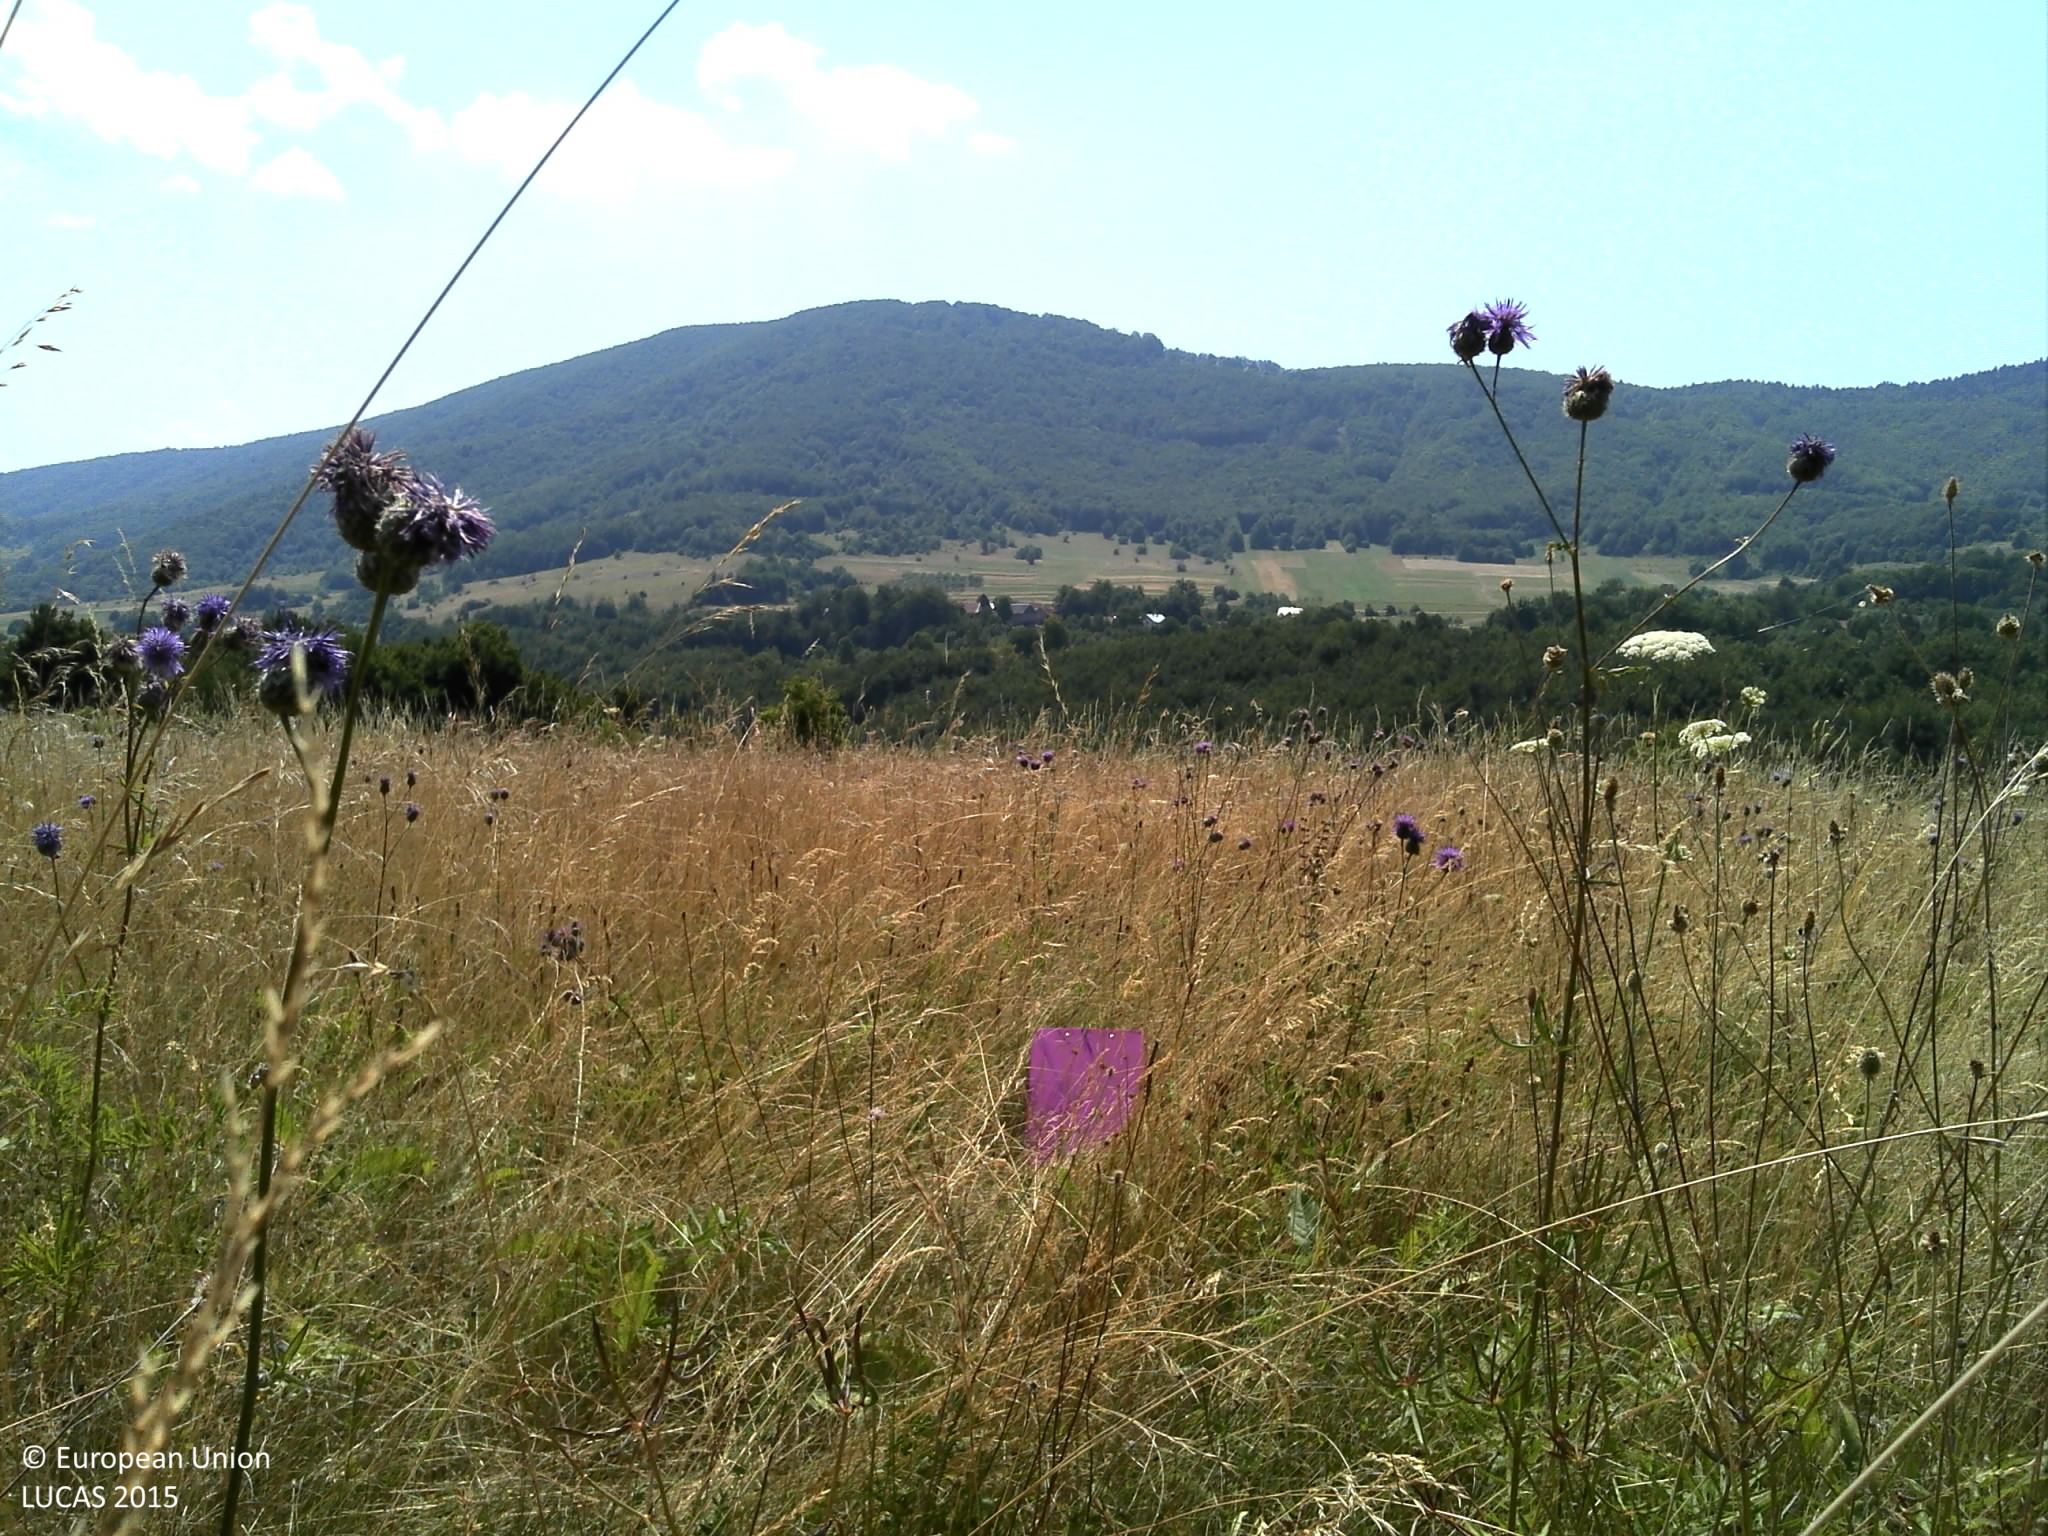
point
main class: Grassland
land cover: Grassland without tree/shrub cover
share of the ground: > 75 %
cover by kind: herbaceous plants 100 %
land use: Semi-natural and natural areas not in use
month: July
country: HR
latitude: 45.0121
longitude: 15.2604
